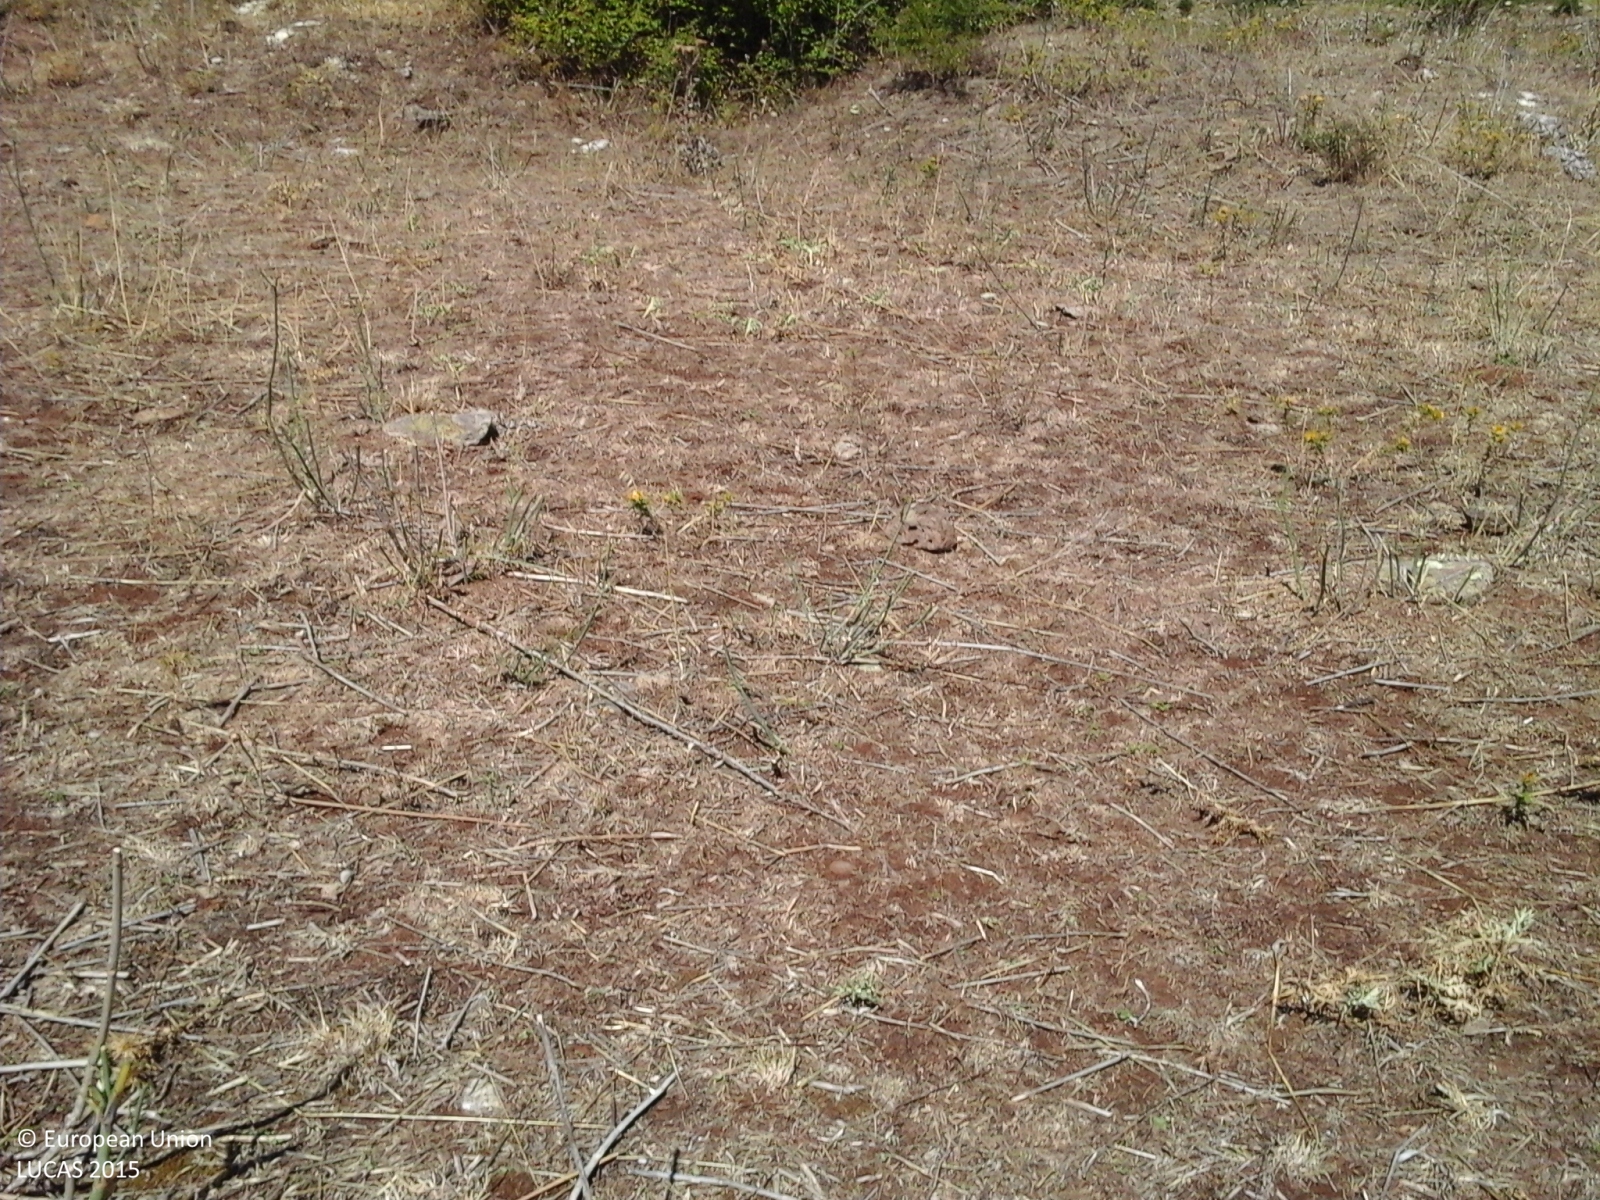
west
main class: Shrubland
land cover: Shrubland without tree cover
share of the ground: > 75 %
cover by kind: herbaceous plants 70 %, shrubs 30 %
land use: Agriculture (excluding fallow land and kitchen gardens)
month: July
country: IT
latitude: 37.1129
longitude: 14.8804
